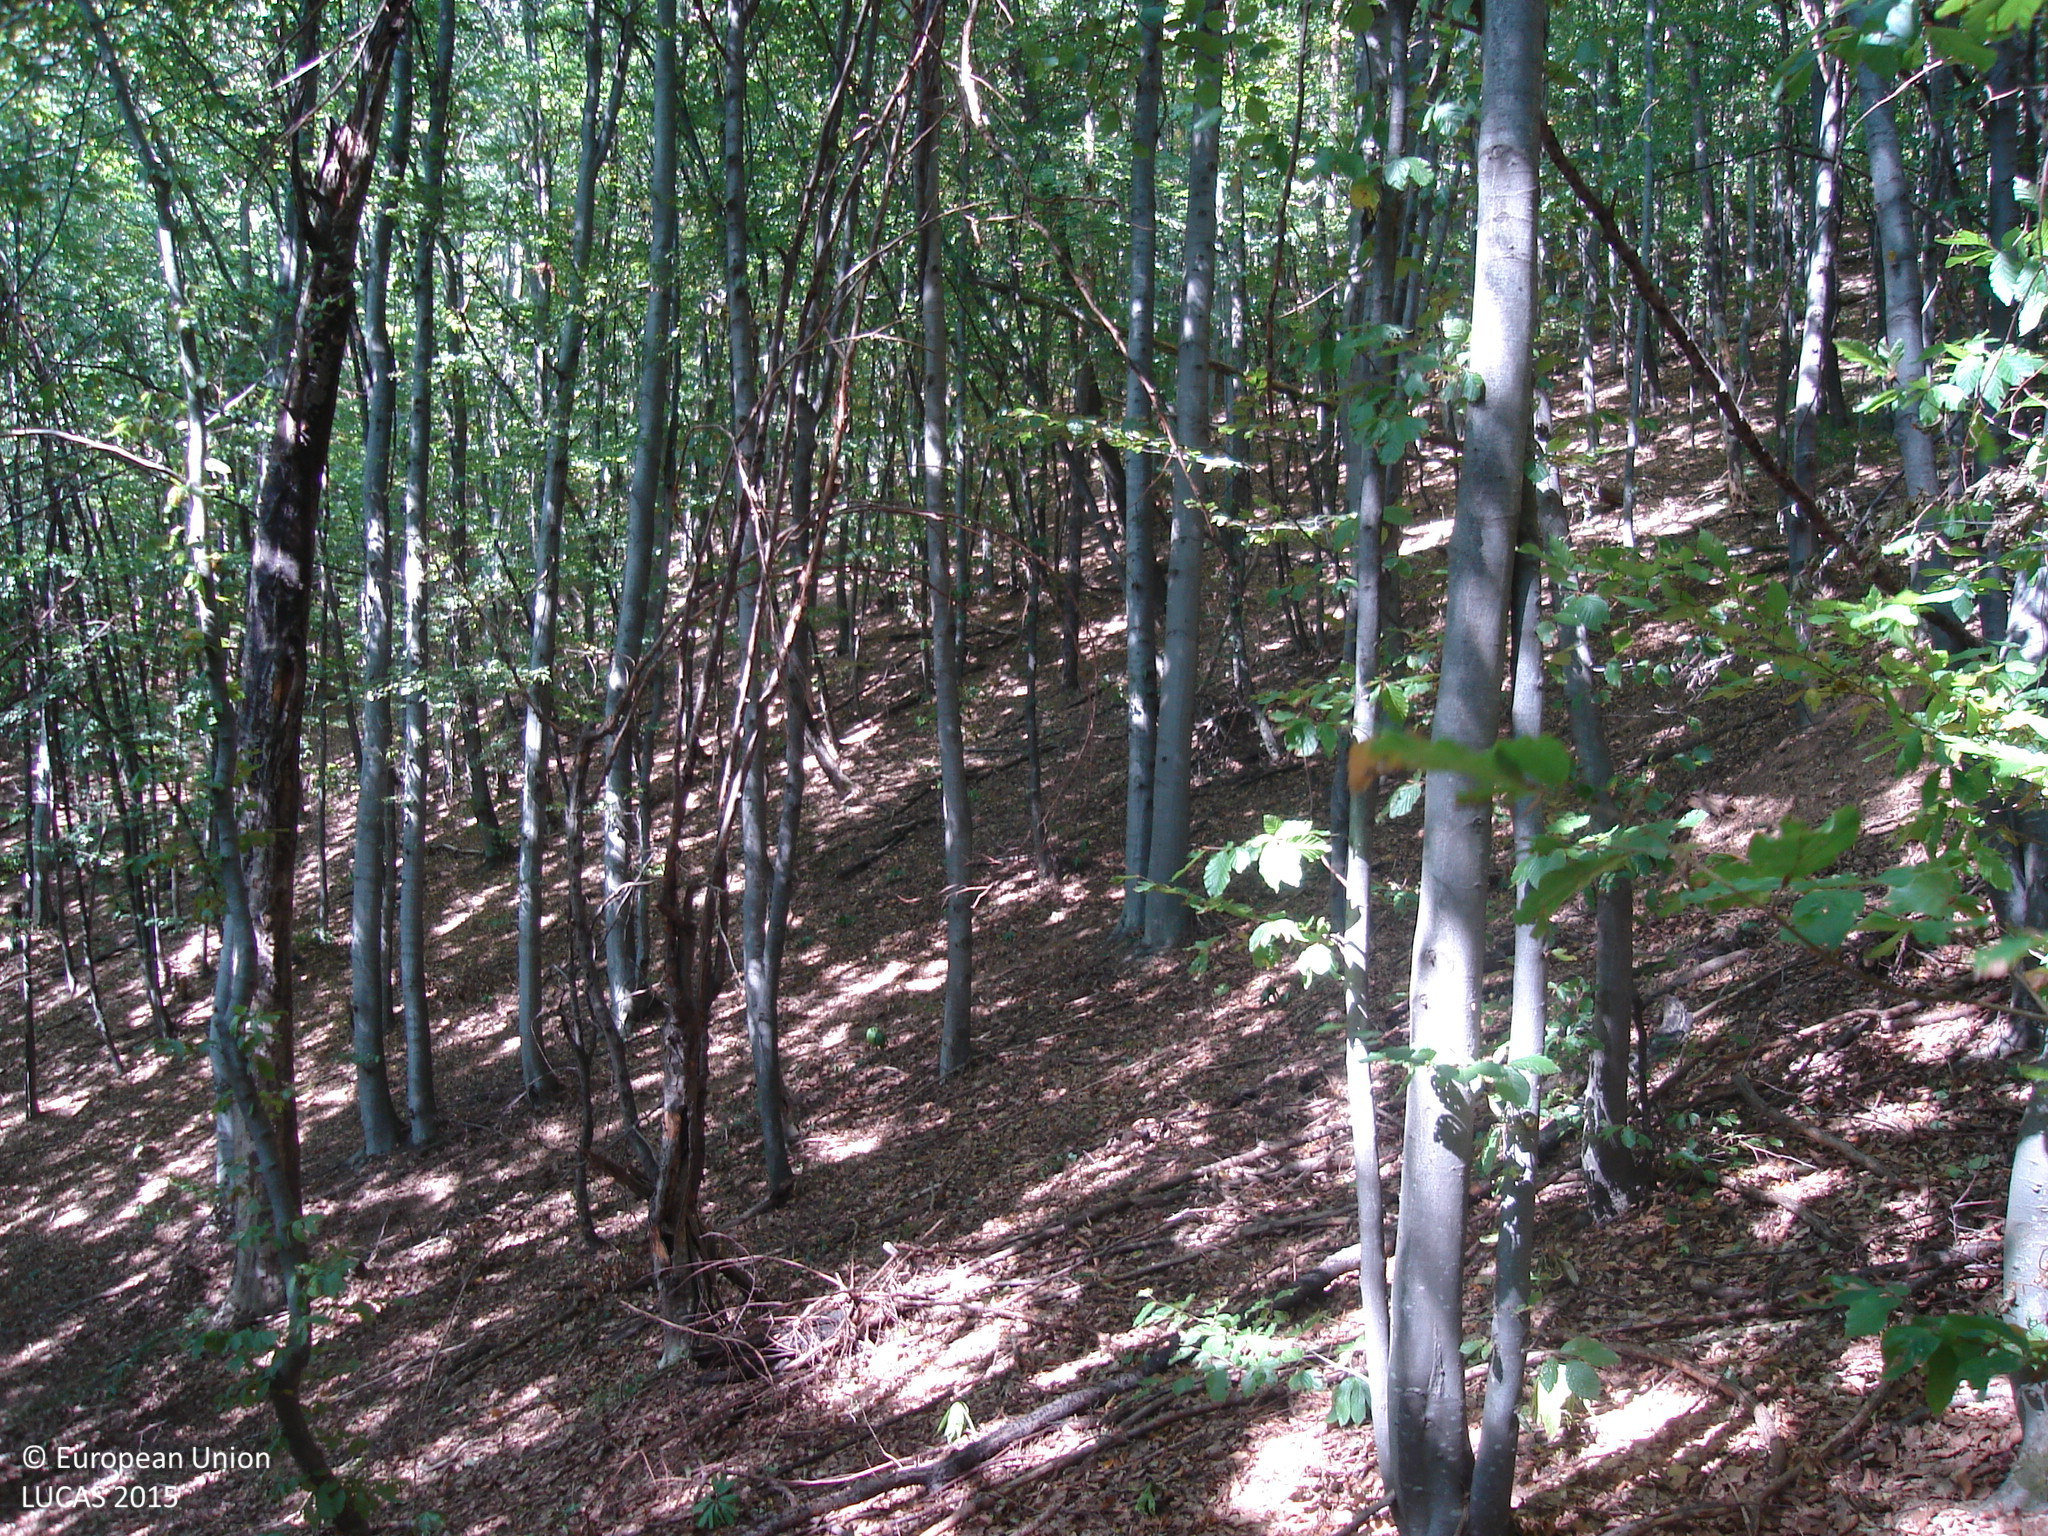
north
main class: Woodland
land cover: Broadleaved woodland
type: beech forest
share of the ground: > 75 %
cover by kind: broadleaved forest trees 80 %, consolidated bare surface 20 %
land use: Forestry
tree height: > 5 m
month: September
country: BG
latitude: 42.8108
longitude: 23.9995
